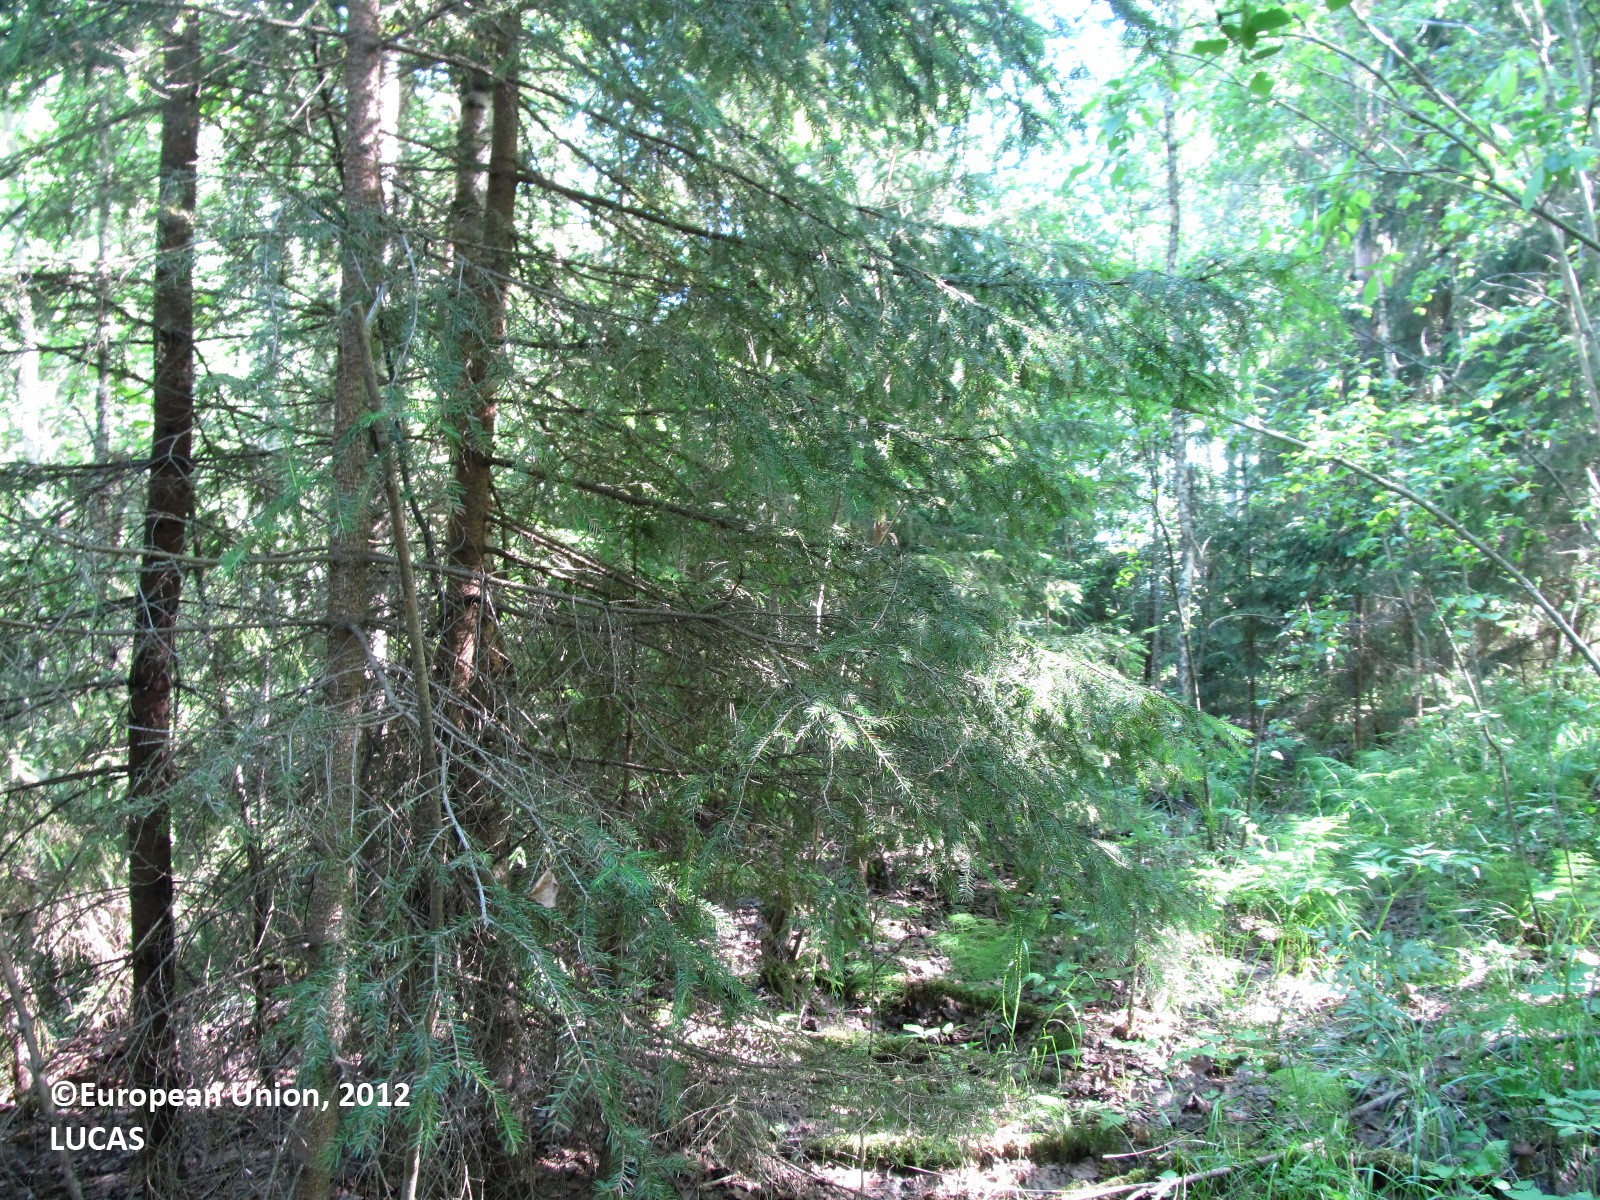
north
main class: Woodland
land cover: Spruce dominated mixed woodland
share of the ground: 50 - 75 %
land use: Forestry
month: July
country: FI
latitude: 62.2484
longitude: 29.2321
